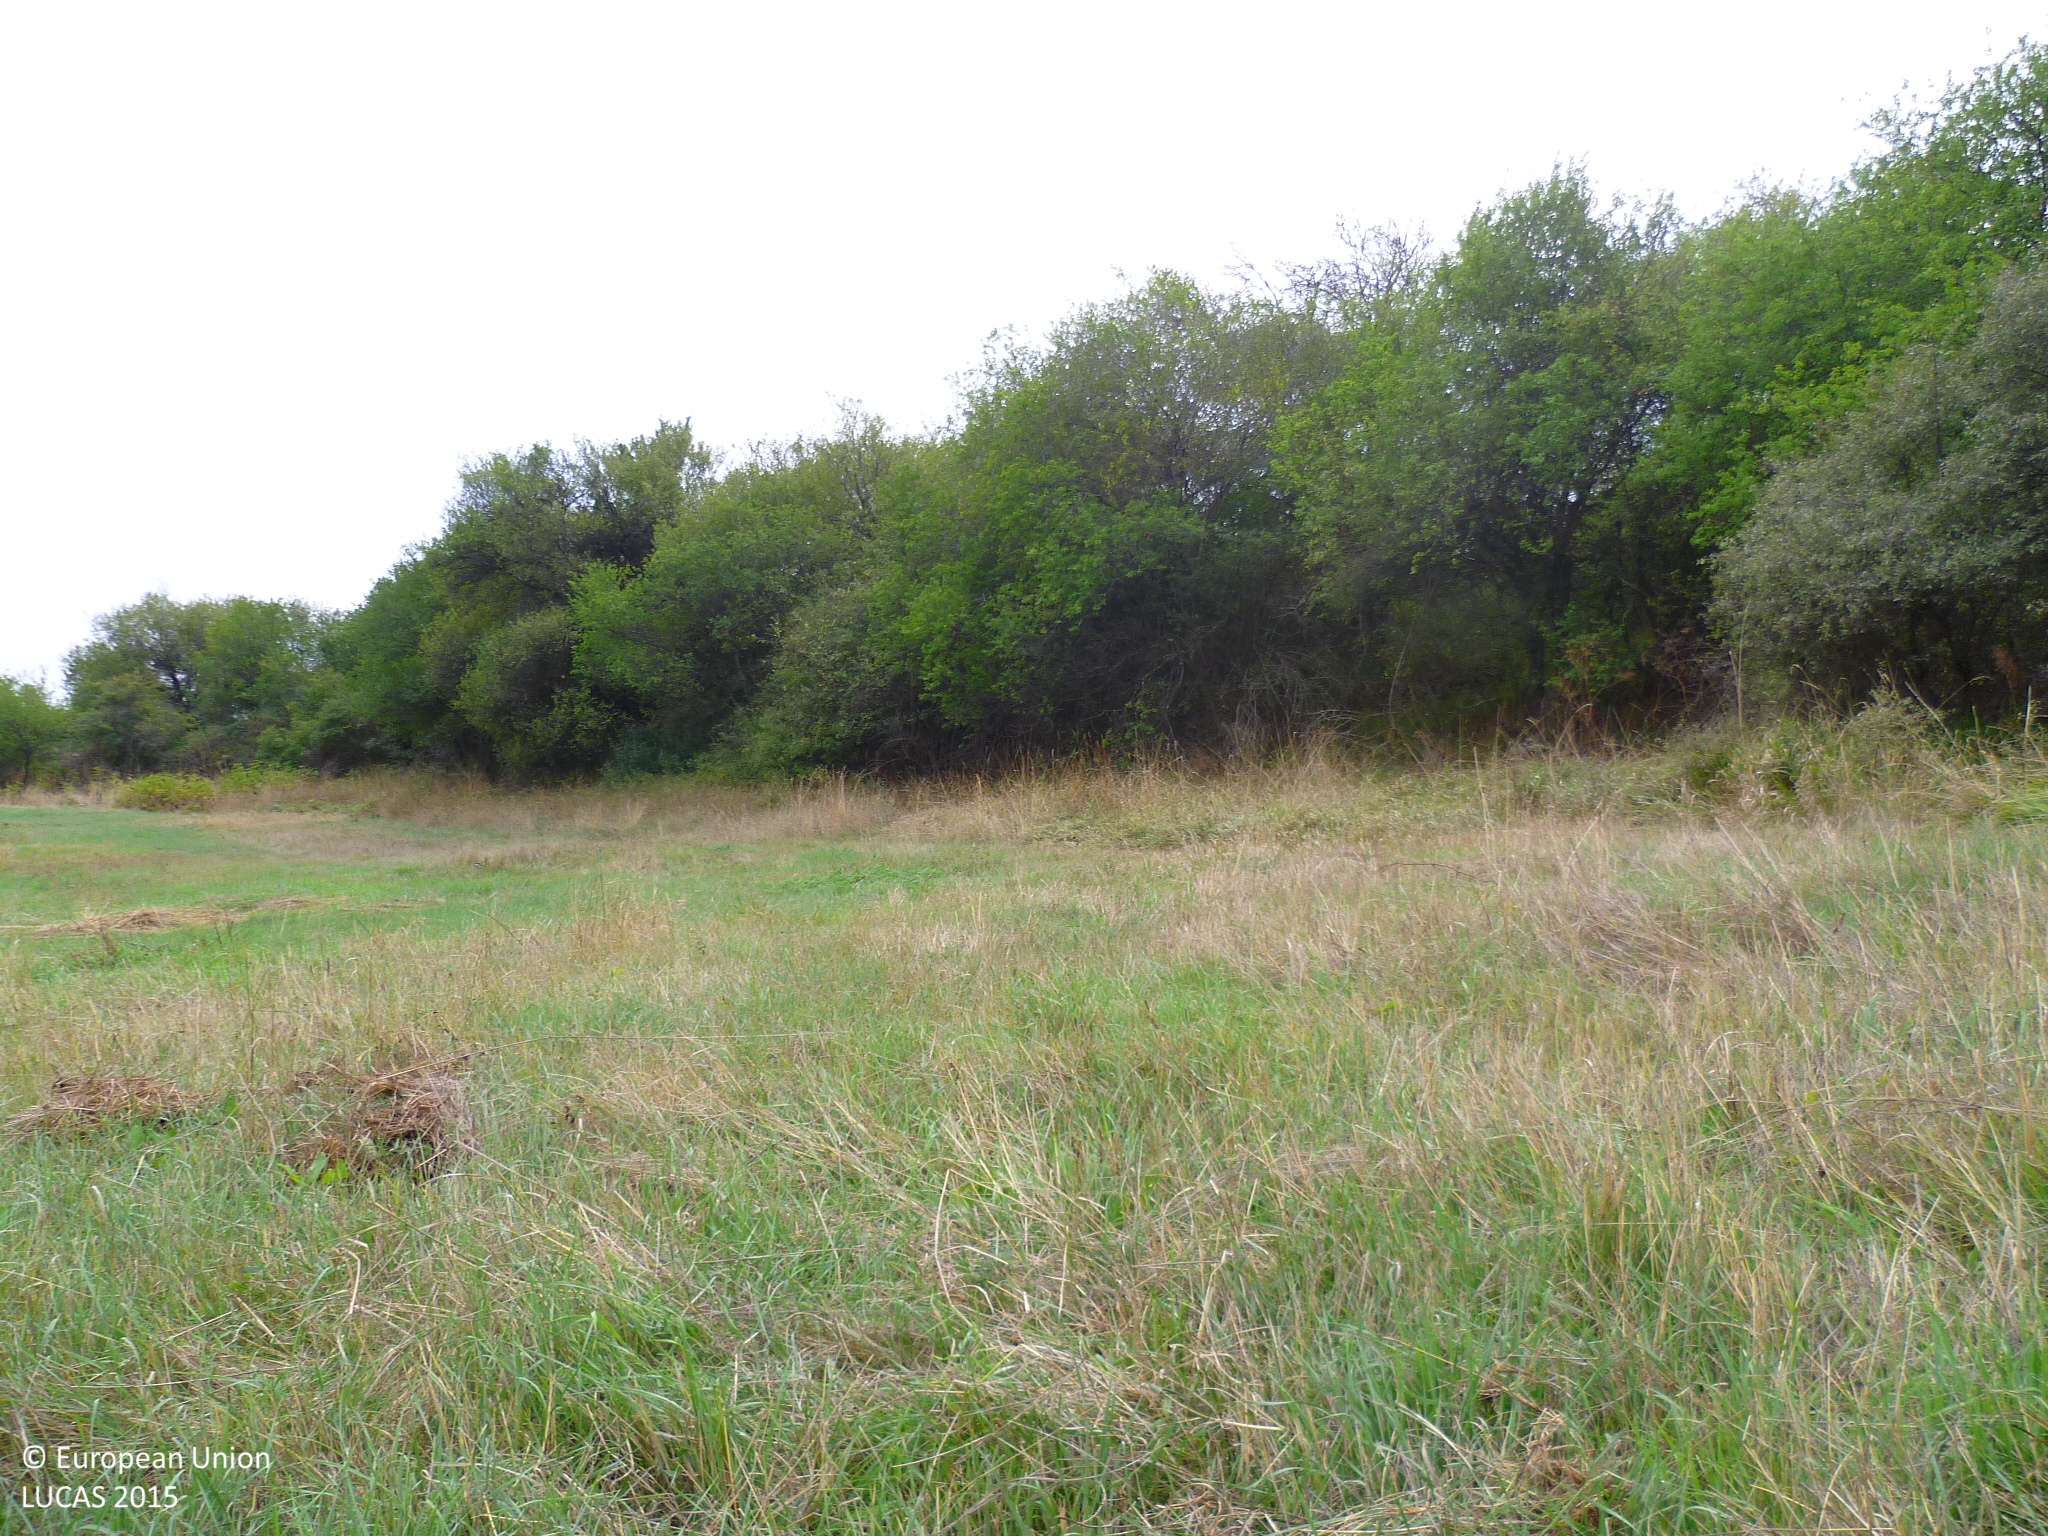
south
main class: Grassland
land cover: Grassland without tree/shrub cover
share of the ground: > 75 %
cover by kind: herbaceous plants 100 %
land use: Agriculture (excluding fallow land and kitchen gardens)
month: September
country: BG
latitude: 42.7658
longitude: 22.9715
